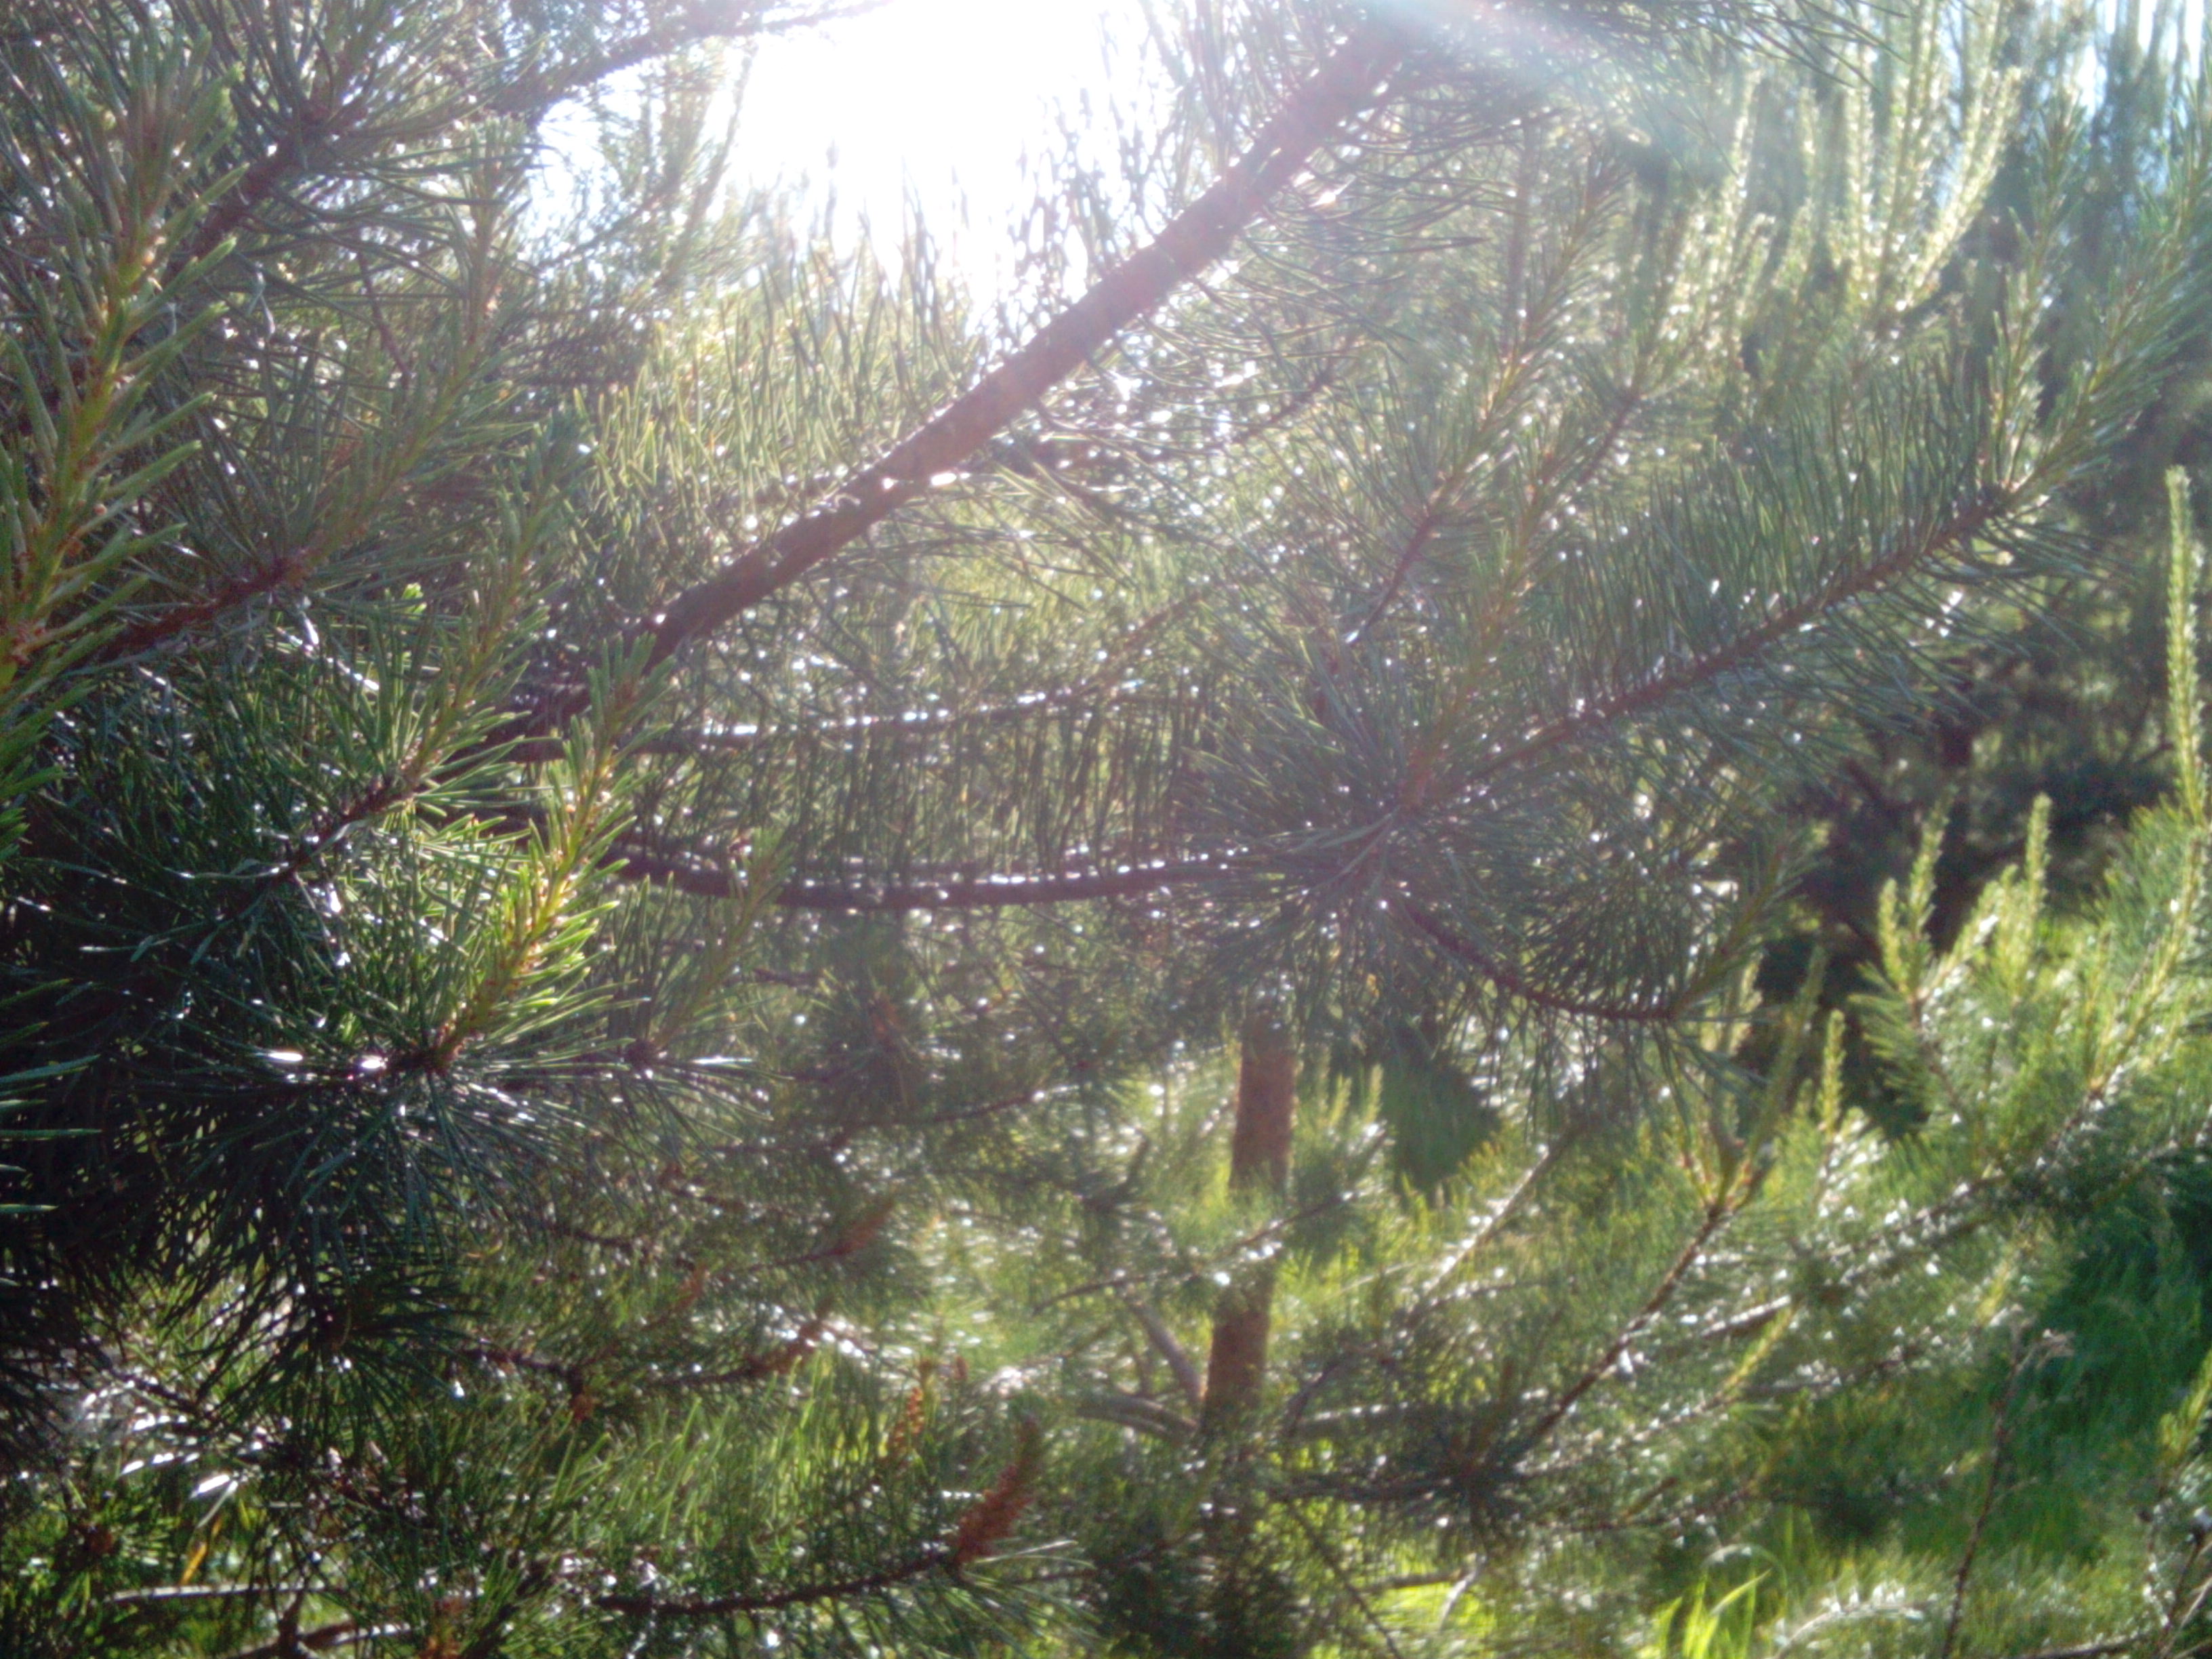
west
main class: Woodland
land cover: Pine dominated coniferous woodland
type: hemiboreal forest and nemoral coniferous forest and mixed broadleaved-coniferous forest
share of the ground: 50 - 75 %
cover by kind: coniferous forest trees 50 %, herbaceous plants 50 %
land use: Forestry
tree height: < 5 m
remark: Nursery
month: June
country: LV
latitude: 56.7208
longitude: 22.1260
